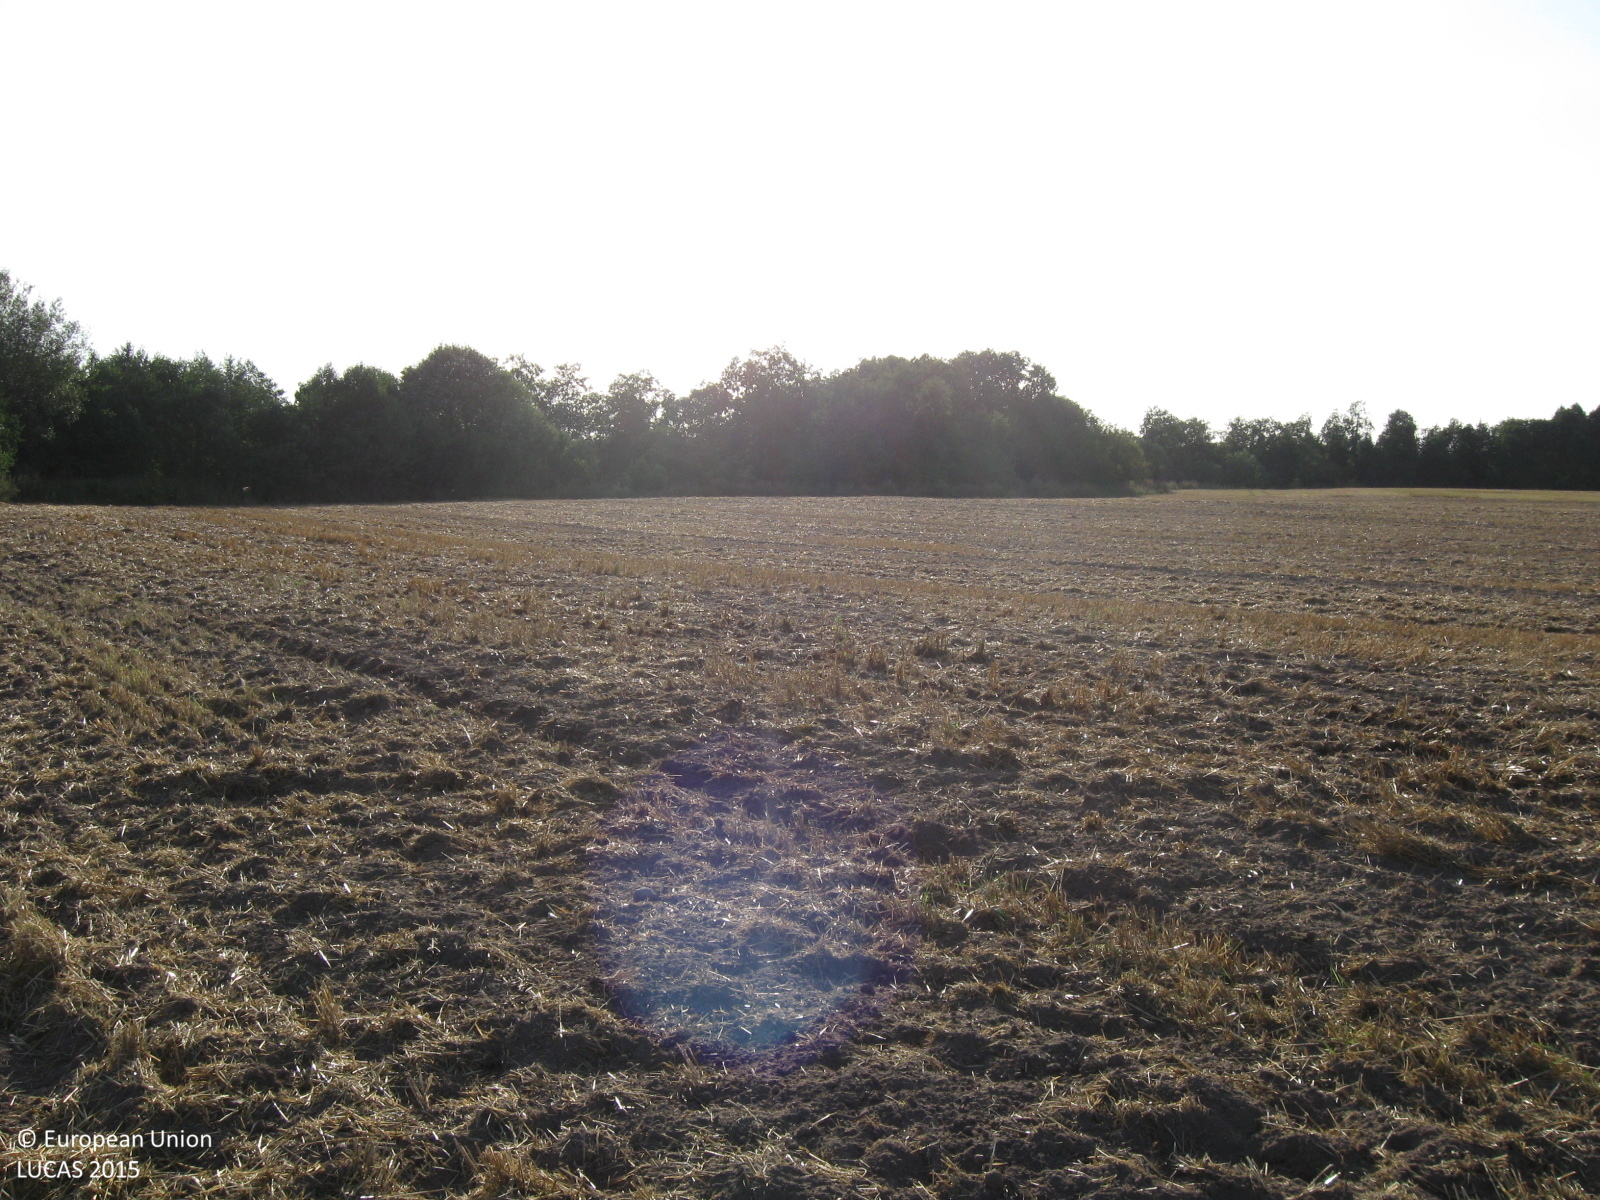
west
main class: Cropland
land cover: Barley
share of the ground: < 10 %
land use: Agriculture (excluding fallow land and kitchen gardens)
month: August
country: LT
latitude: 55.3833
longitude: 23.2865
